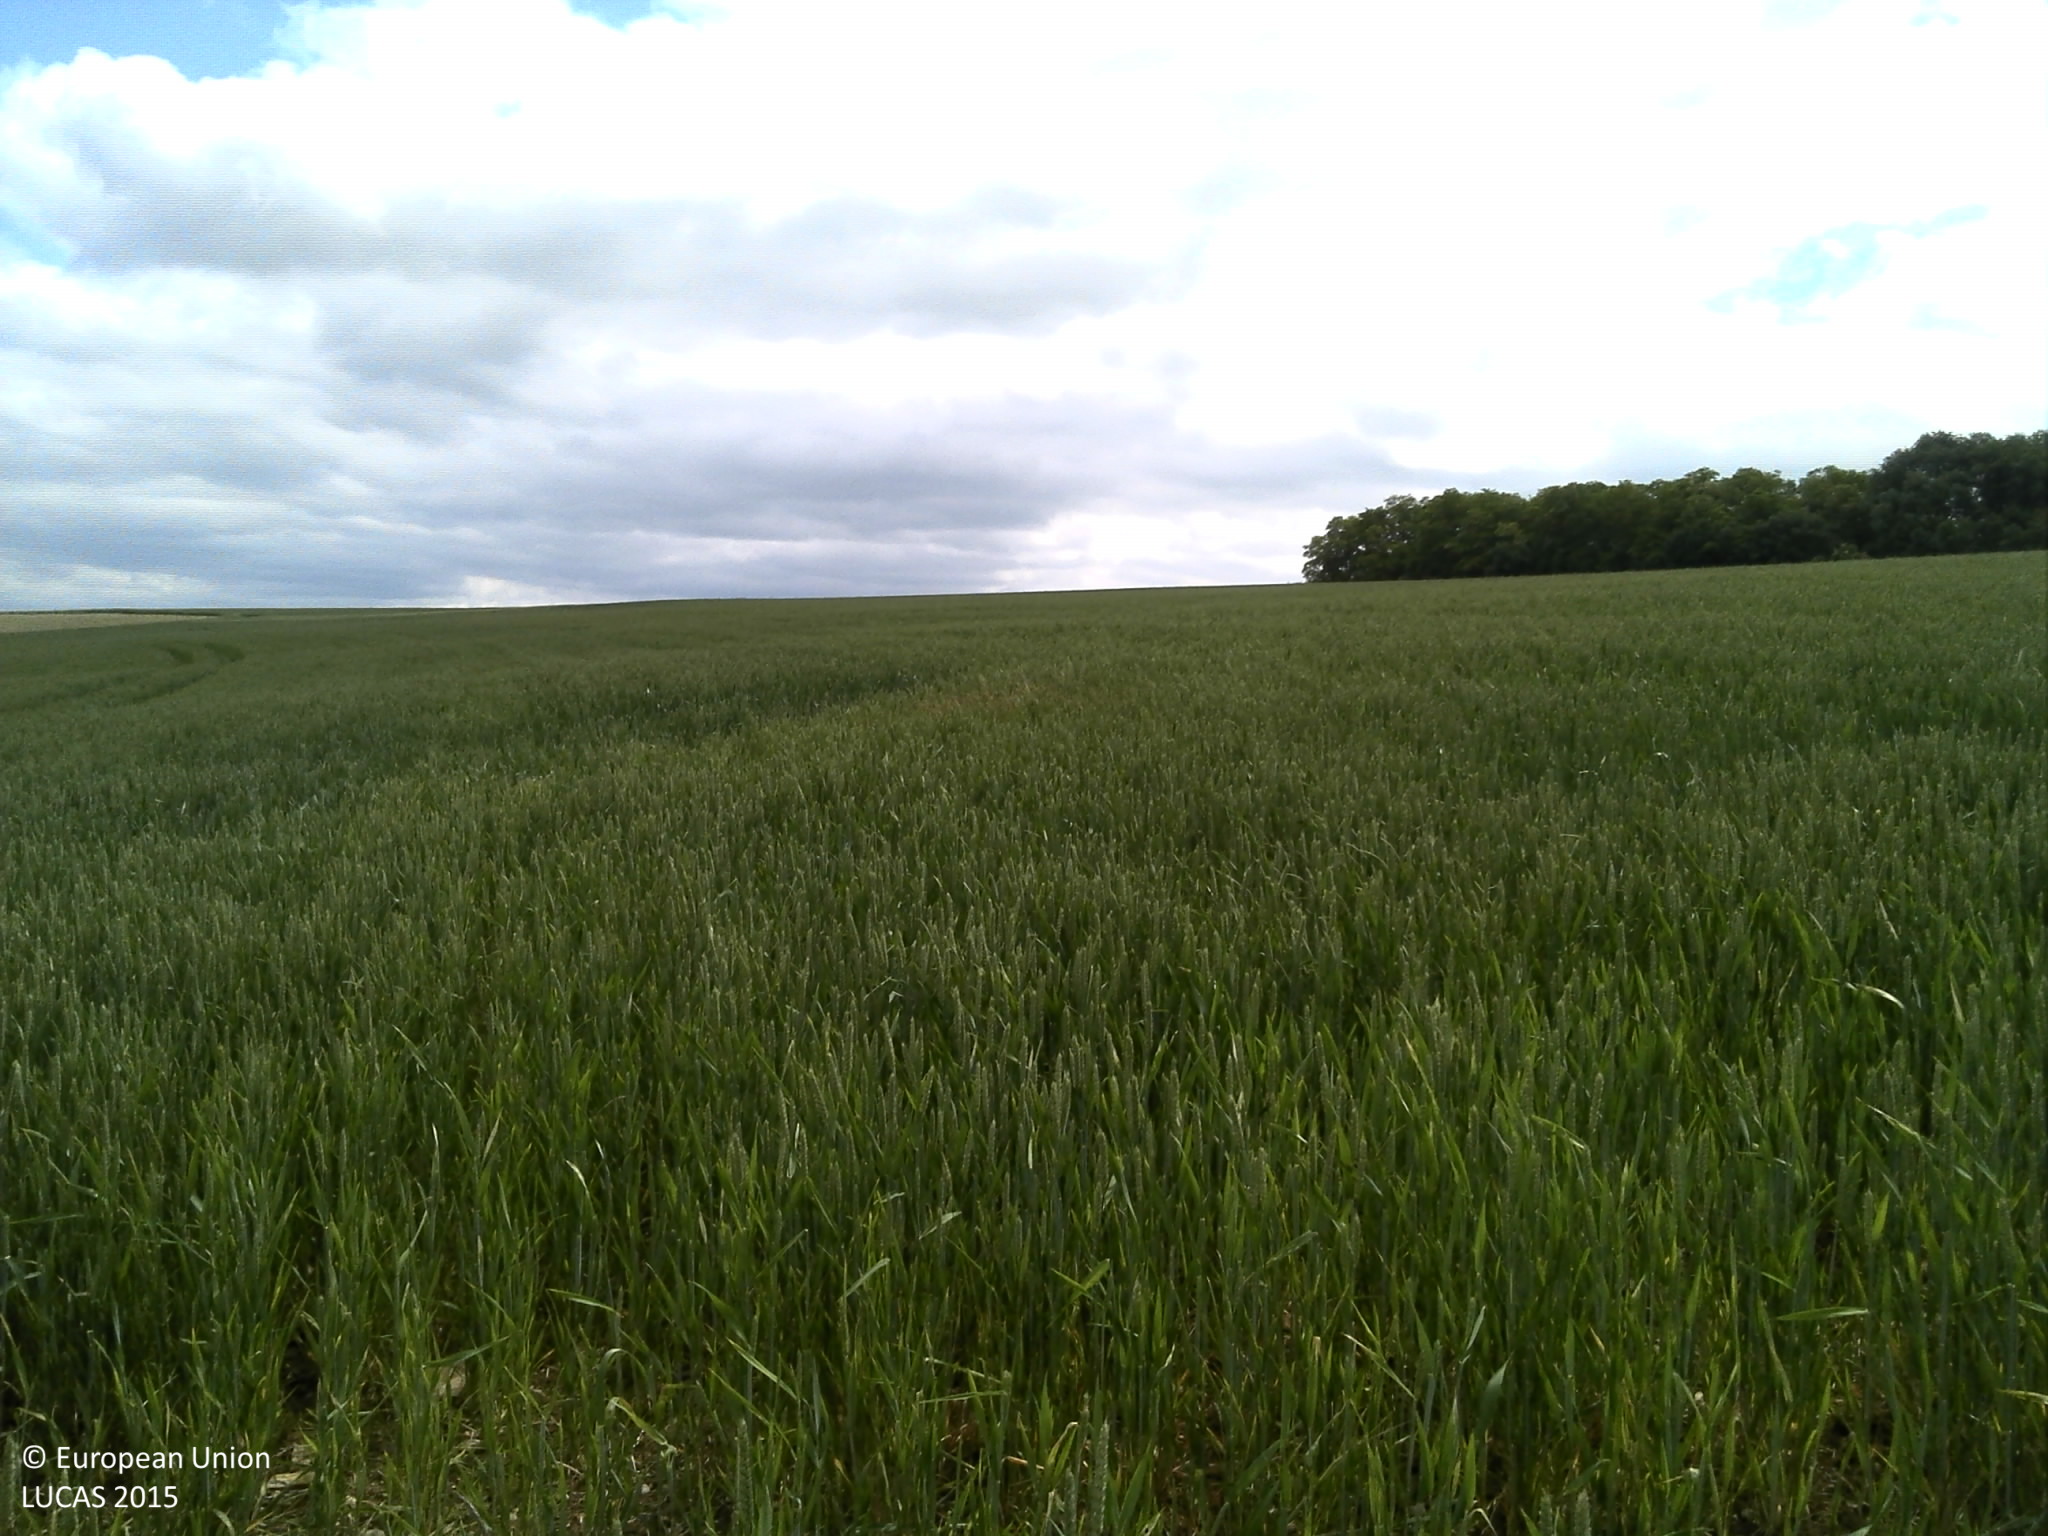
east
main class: Cropland
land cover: Common wheat
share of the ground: > 75 %
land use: Agriculture (excluding fallow land and kitchen gardens)
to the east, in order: Common wheat
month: June
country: FR
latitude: 49.0051
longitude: 6.2132
